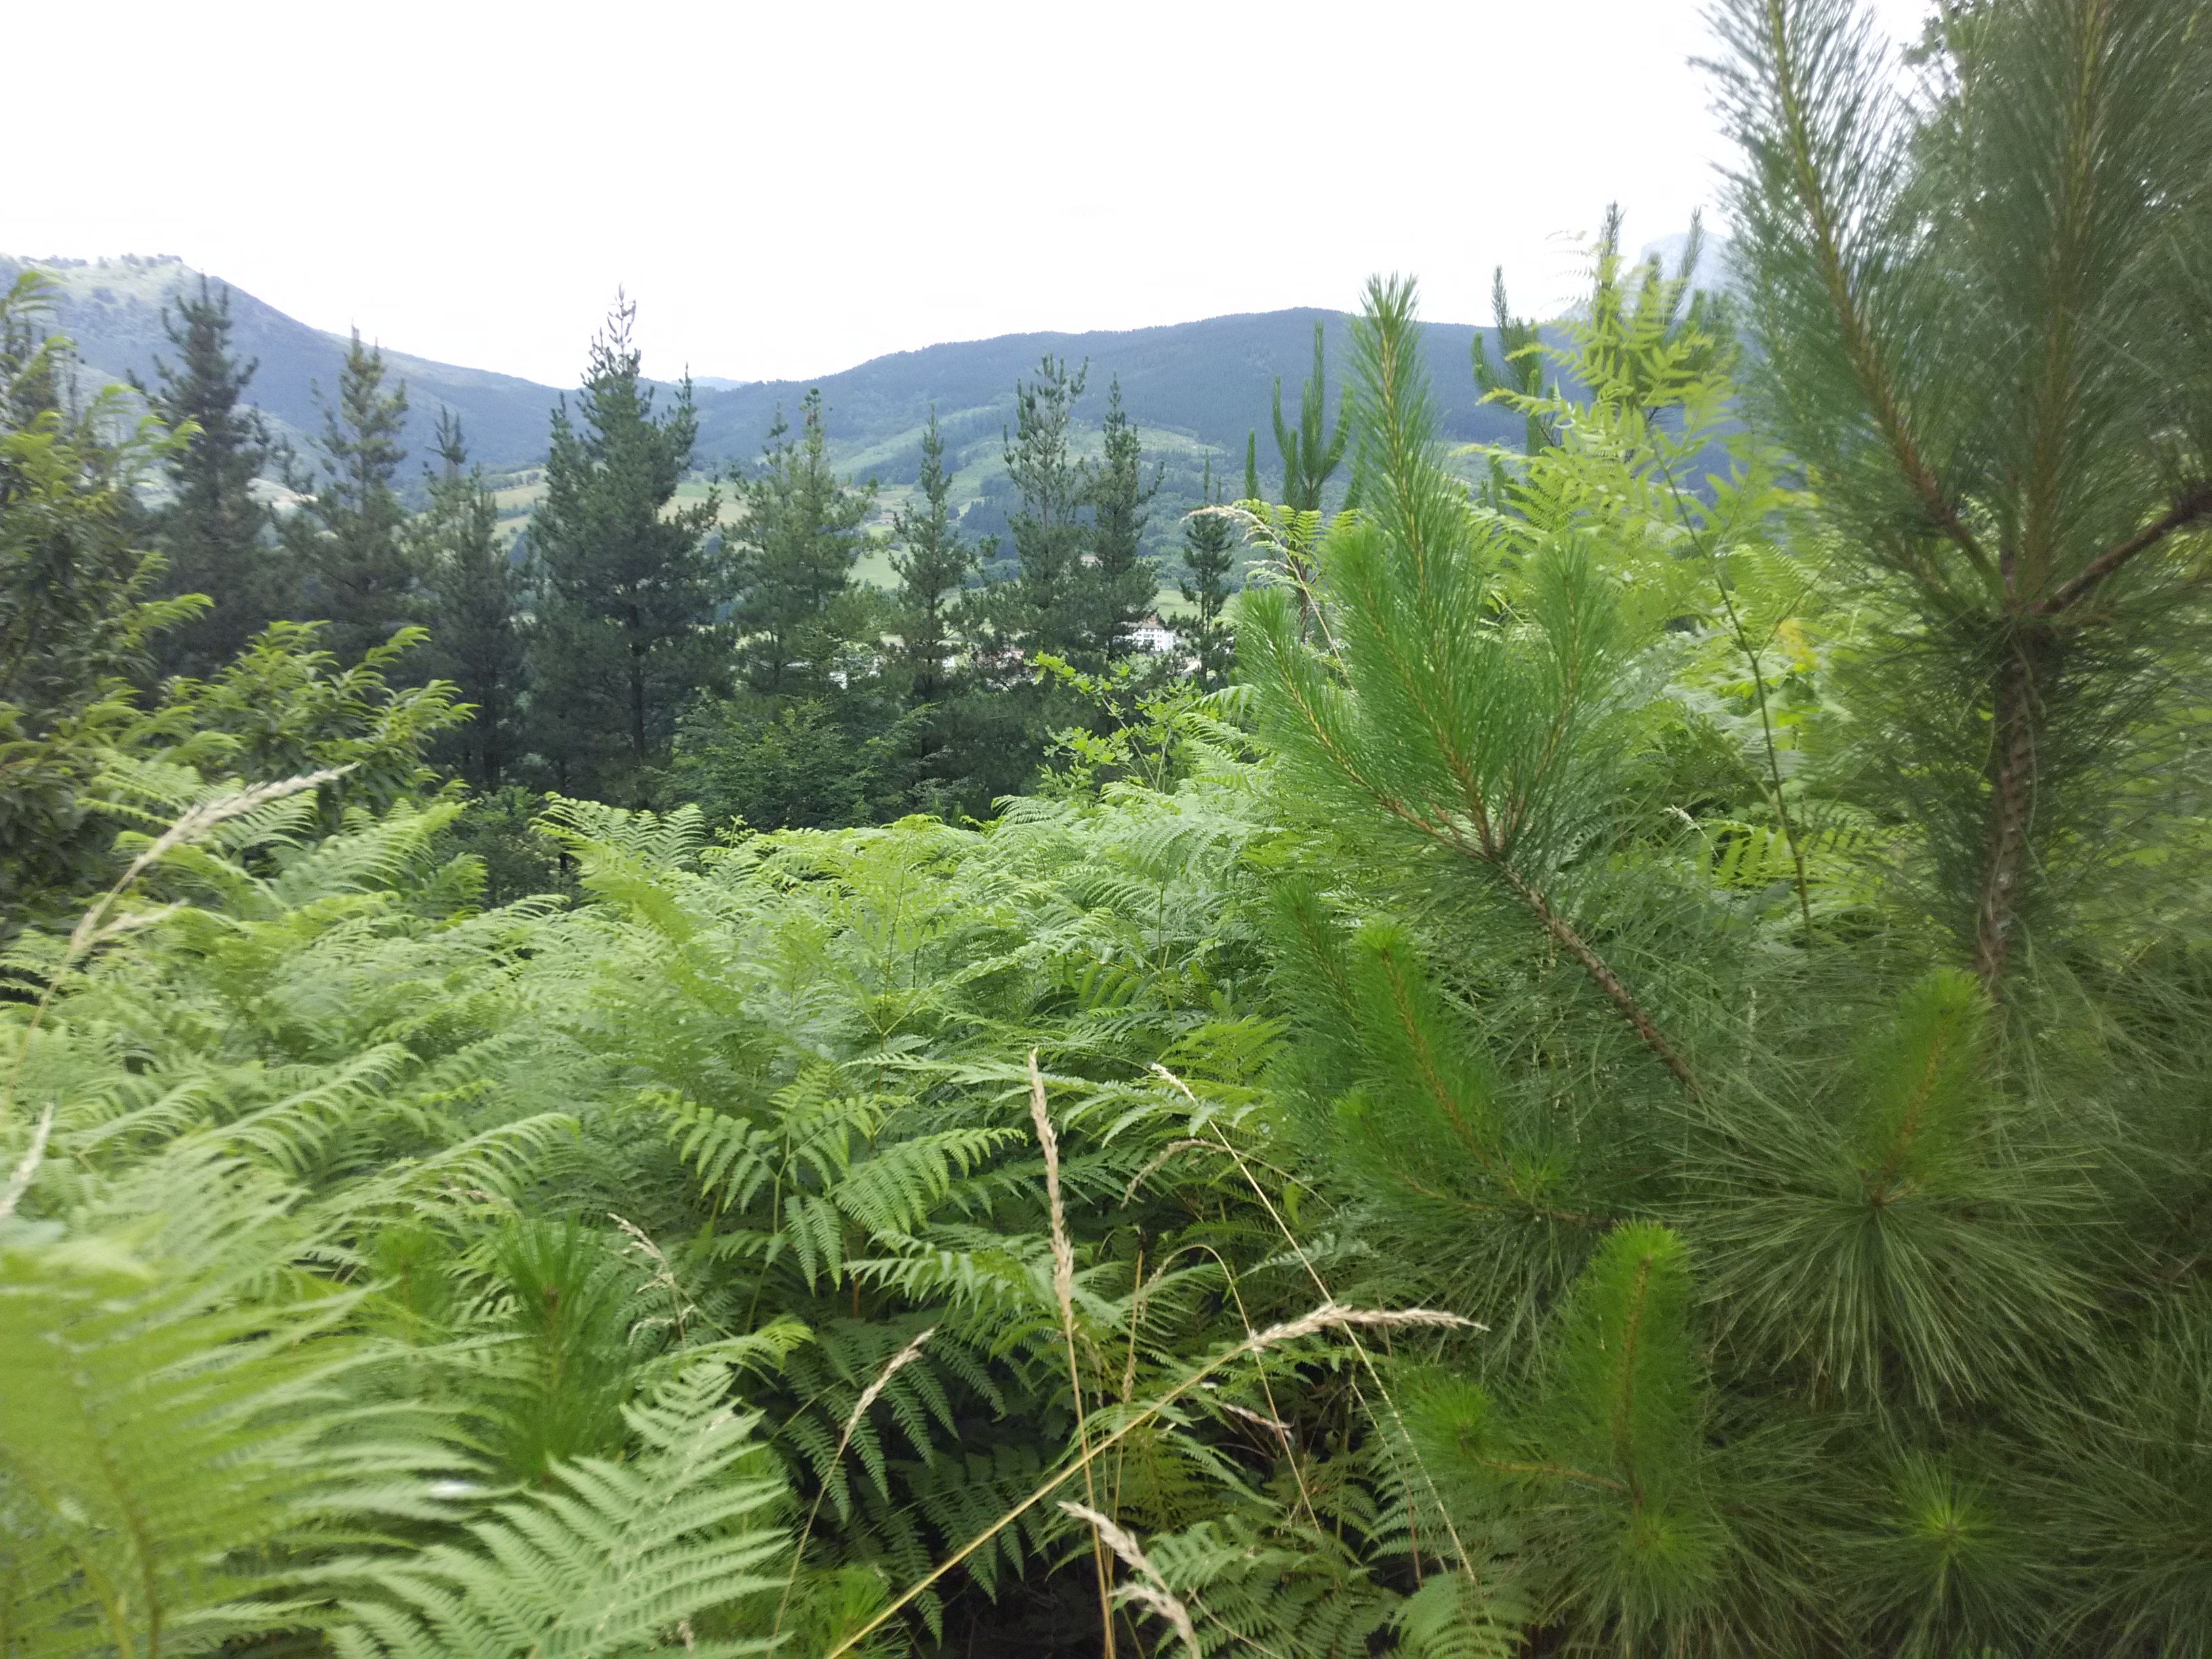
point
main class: Woodland
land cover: Pine dominated coniferous woodland
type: exotic forest
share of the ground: > 75 %
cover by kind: coniferous forest trees 100 %
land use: Forestry
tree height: < 5 m
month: July
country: ES
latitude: 43.1318
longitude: -2.5296
